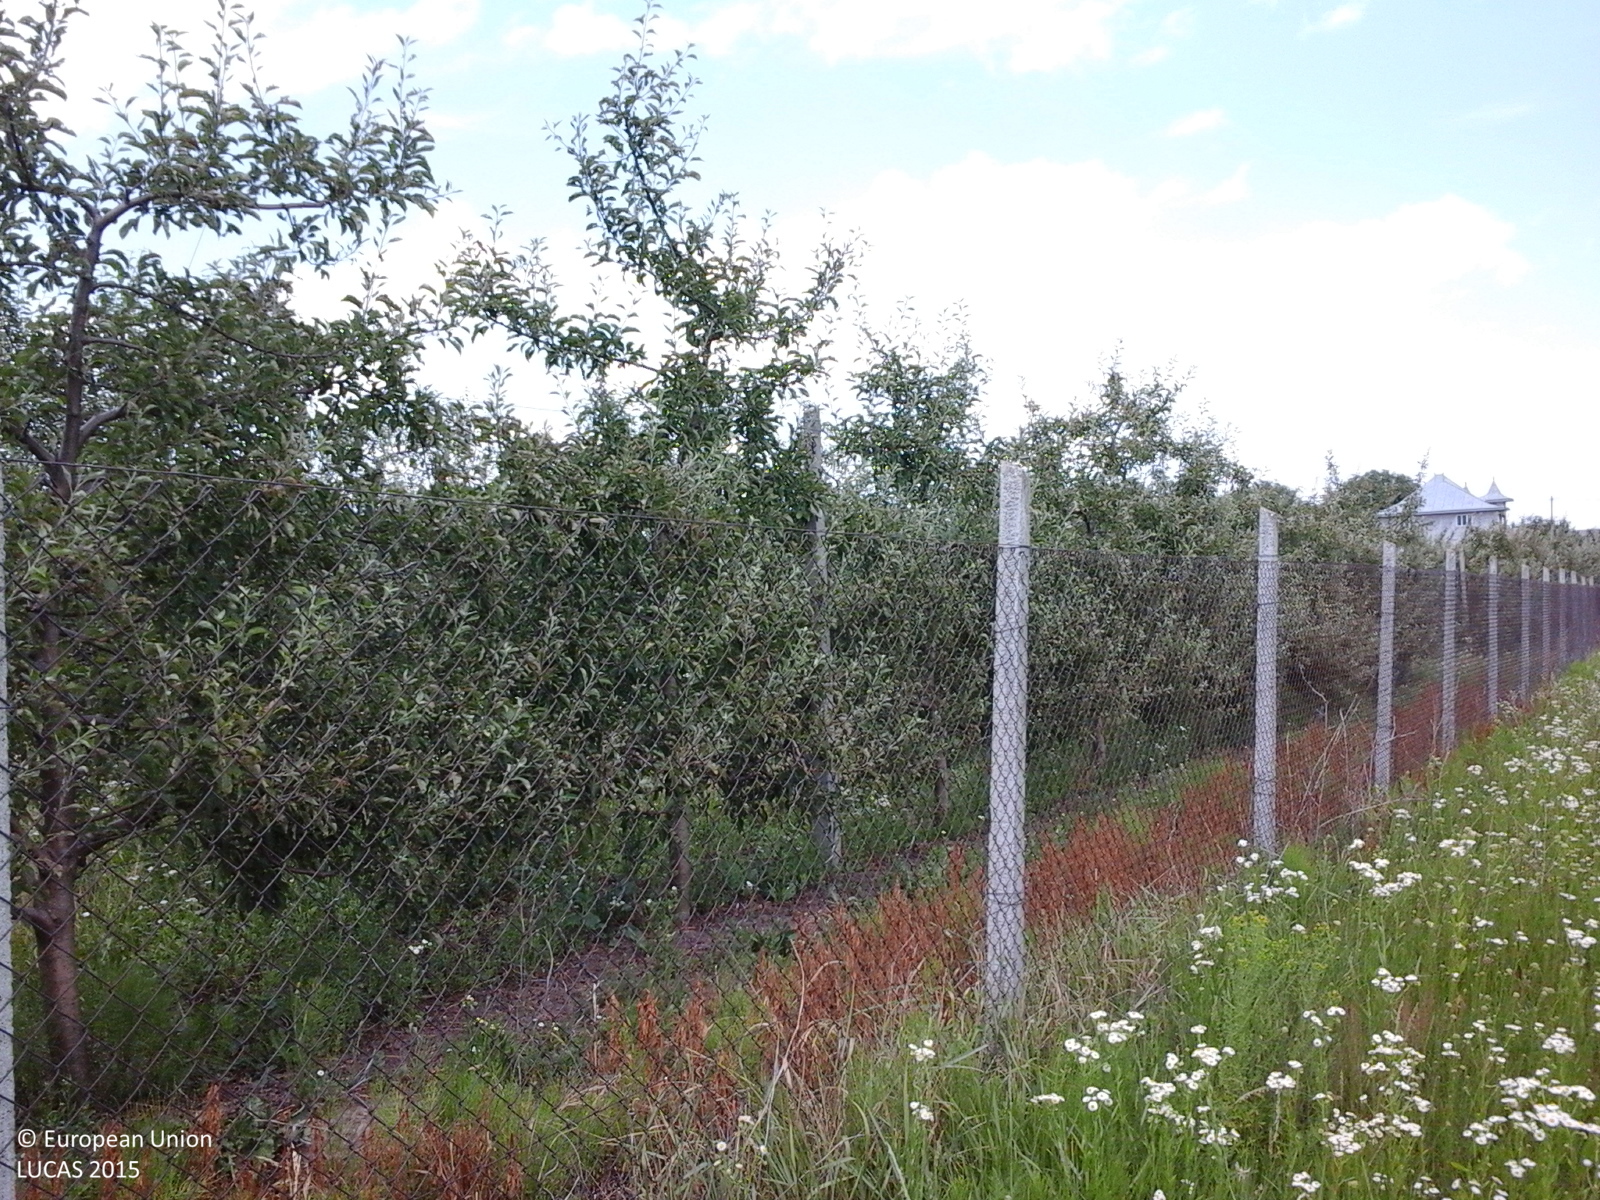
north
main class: Cropland
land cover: Apple fruit
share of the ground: 50 - 75 %
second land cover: Grassland without tree/shrub cover
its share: > 75 %
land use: Agriculture (excluding fallow land and kitchen gardens)
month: June
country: RO
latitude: 47.5179
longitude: 26.2707
